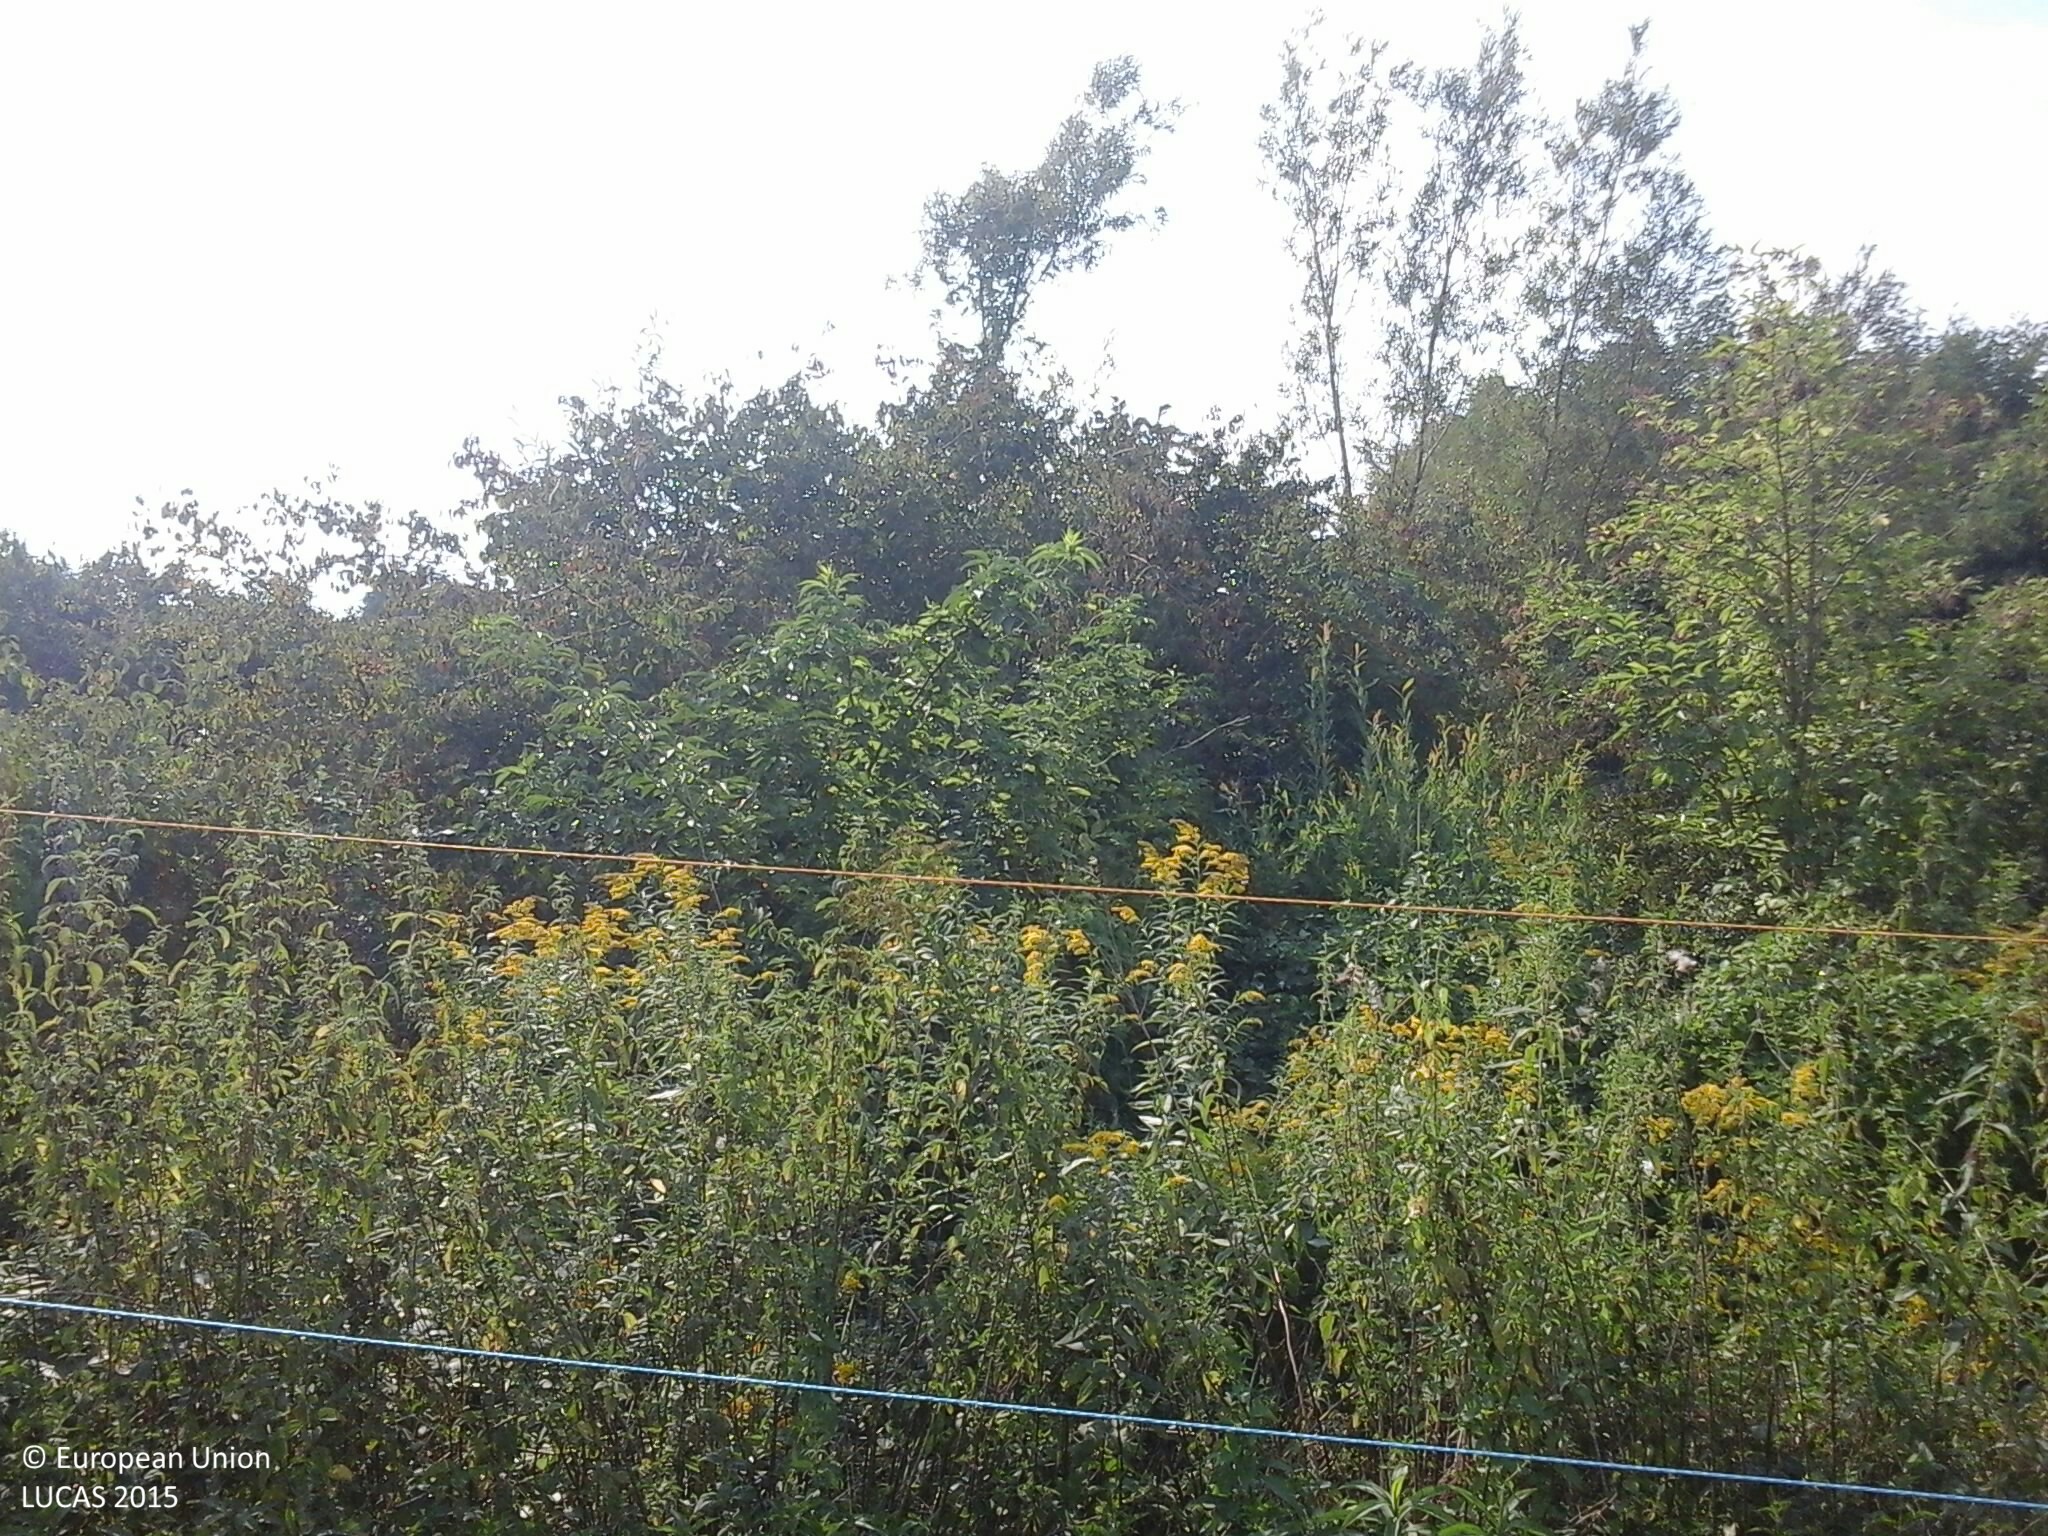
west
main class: Grassland
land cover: Spontaneously vegetated surfaces
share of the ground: > 75 %
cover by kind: herbaceous plants 100 %
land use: Fallow land
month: August
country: HU
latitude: 45.9377
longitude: 18.3004
